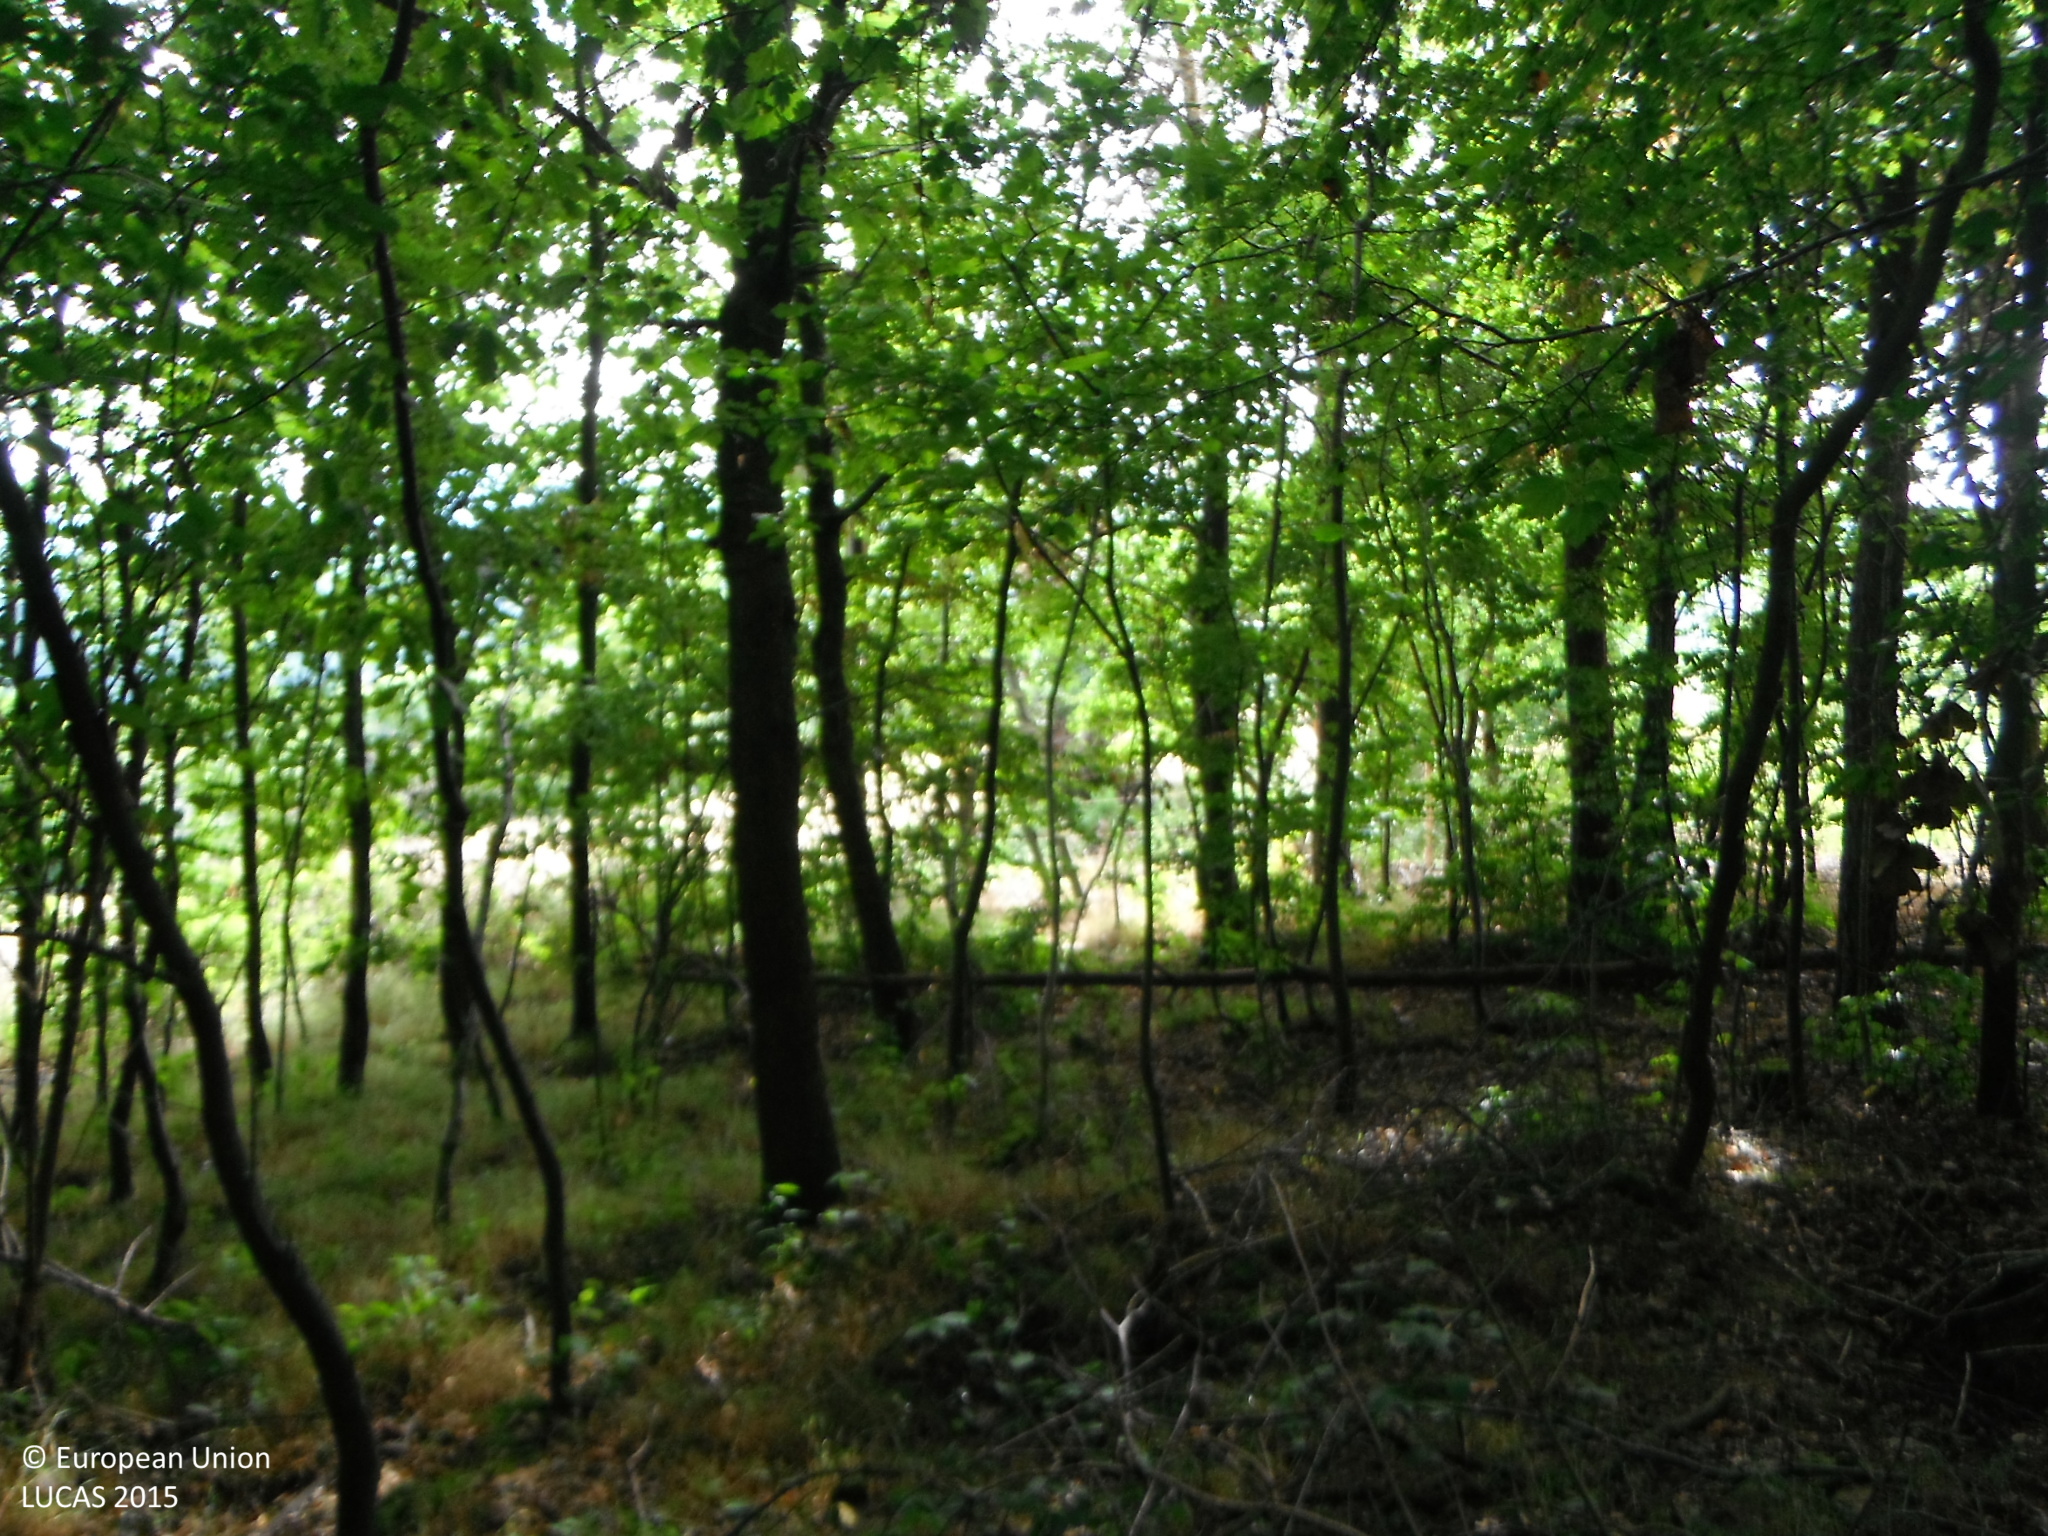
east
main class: Woodland
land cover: Other mixed woodland
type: hemiboreal forest and nemoral coniferous forest and mixed broadleaved-coniferous forest
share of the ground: > 75 %
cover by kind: coniferous forest trees 60 %, broadleaved forest trees 40 %
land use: Forestry
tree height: > 5 m
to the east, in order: Other mixed woodland; Fences; Barley; Fences; Broadleaved woodland
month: July
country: SK
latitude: 48.7582
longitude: 18.3276
